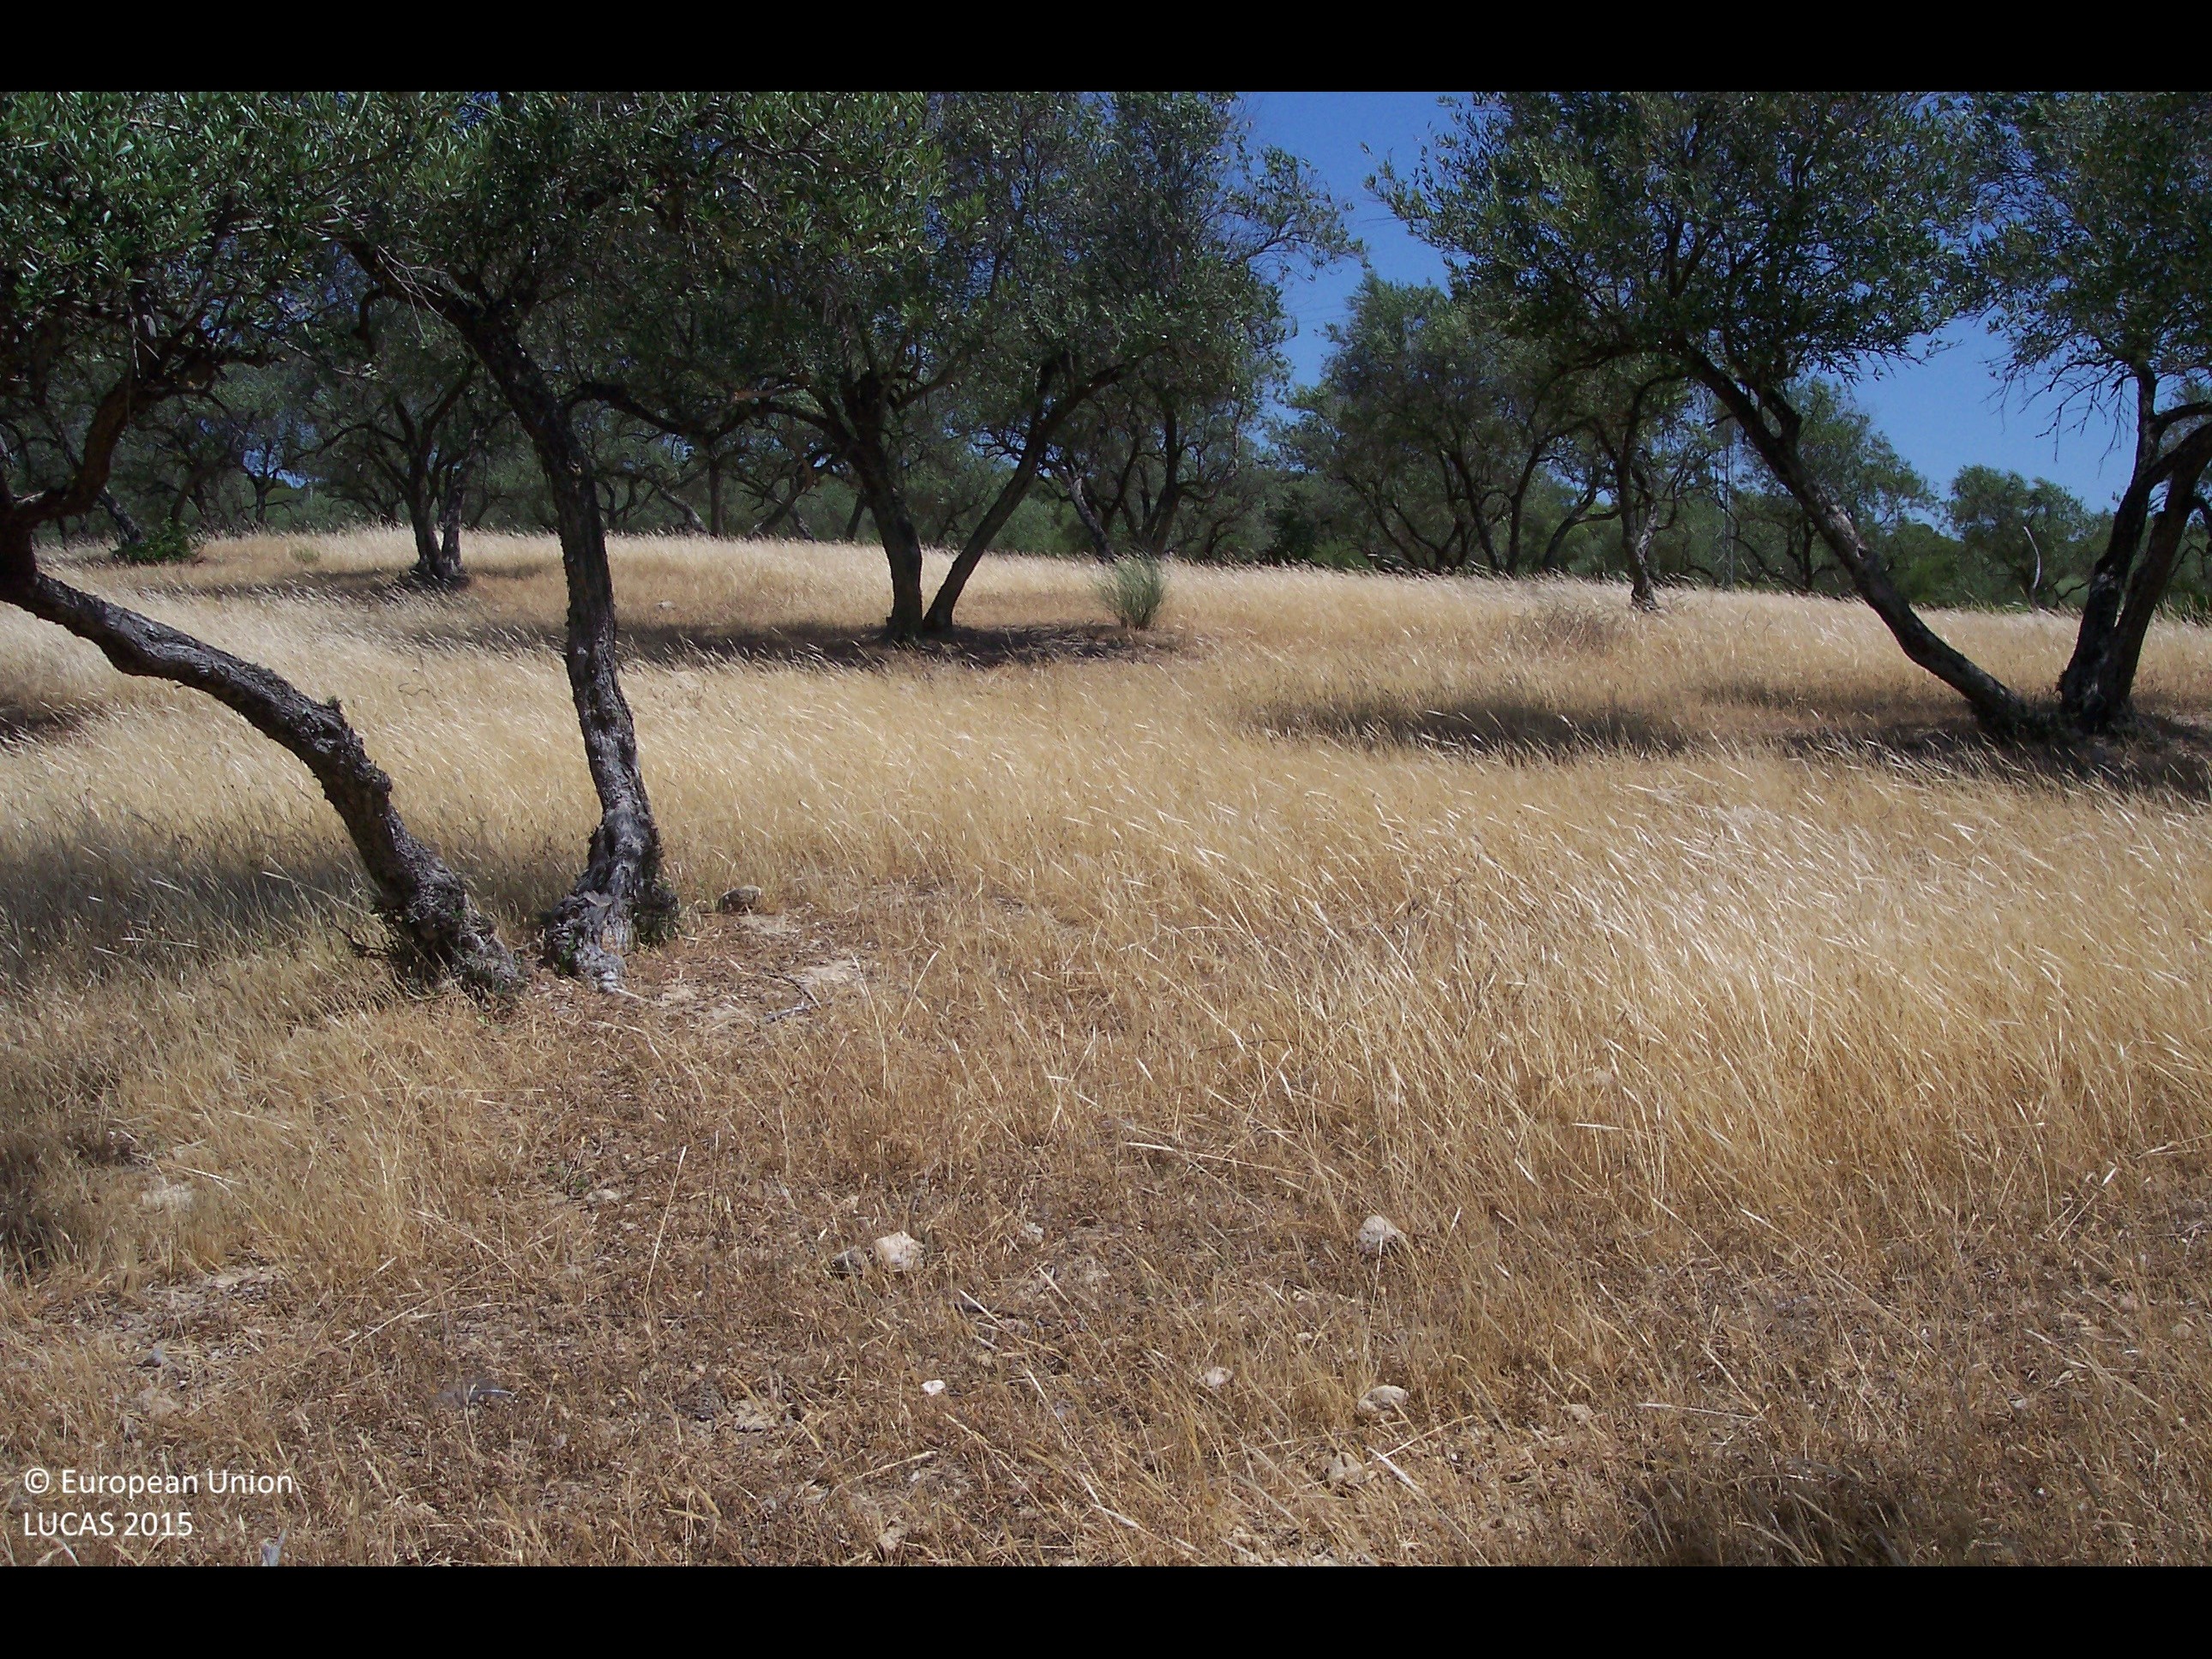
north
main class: Cropland
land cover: Olive groves
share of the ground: 25 - 50 %
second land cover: Spontaneously vegetated surfaces
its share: > 75 %
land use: Agriculture (excluding fallow land and kitchen gardens)
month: June
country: ES
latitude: 37.5619
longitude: -6.1160
